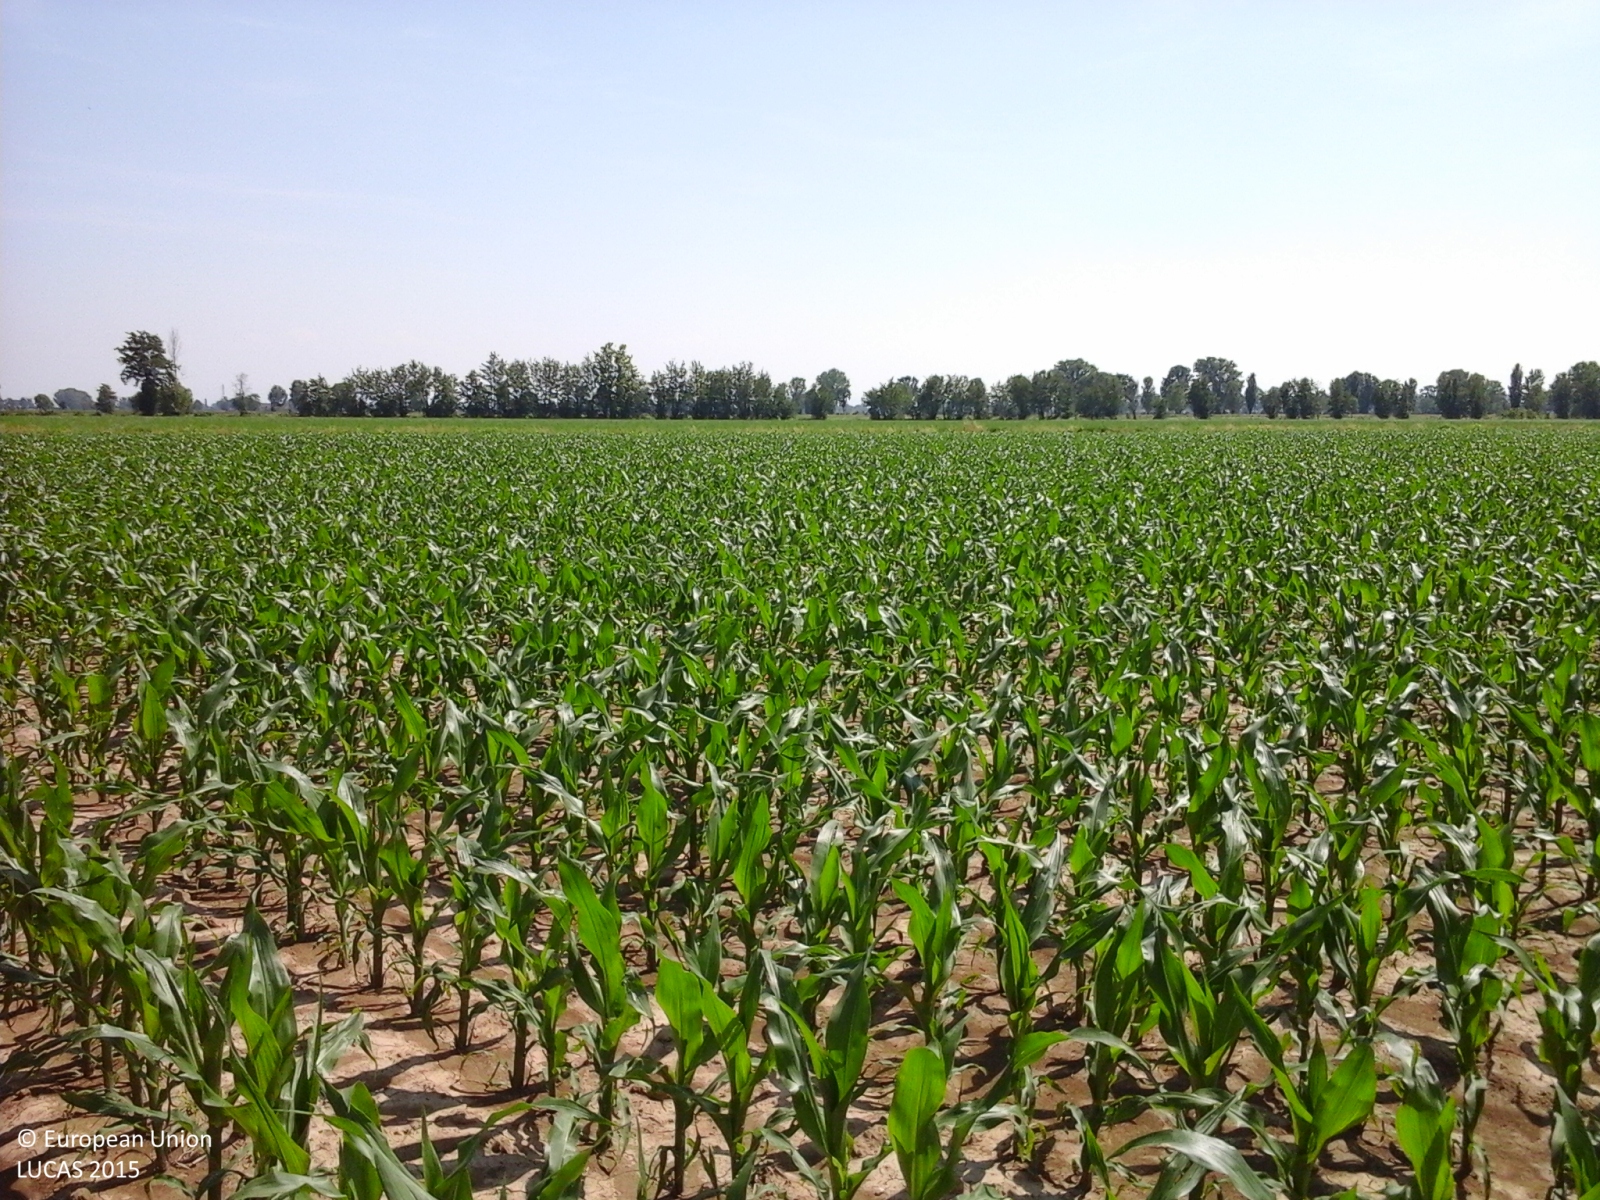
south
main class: Cropland
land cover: Maize
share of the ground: 50 - 75 %
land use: Agriculture (excluding fallow land and kitchen gardens)
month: May
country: IT
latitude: 45.2330
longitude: 9.5296
